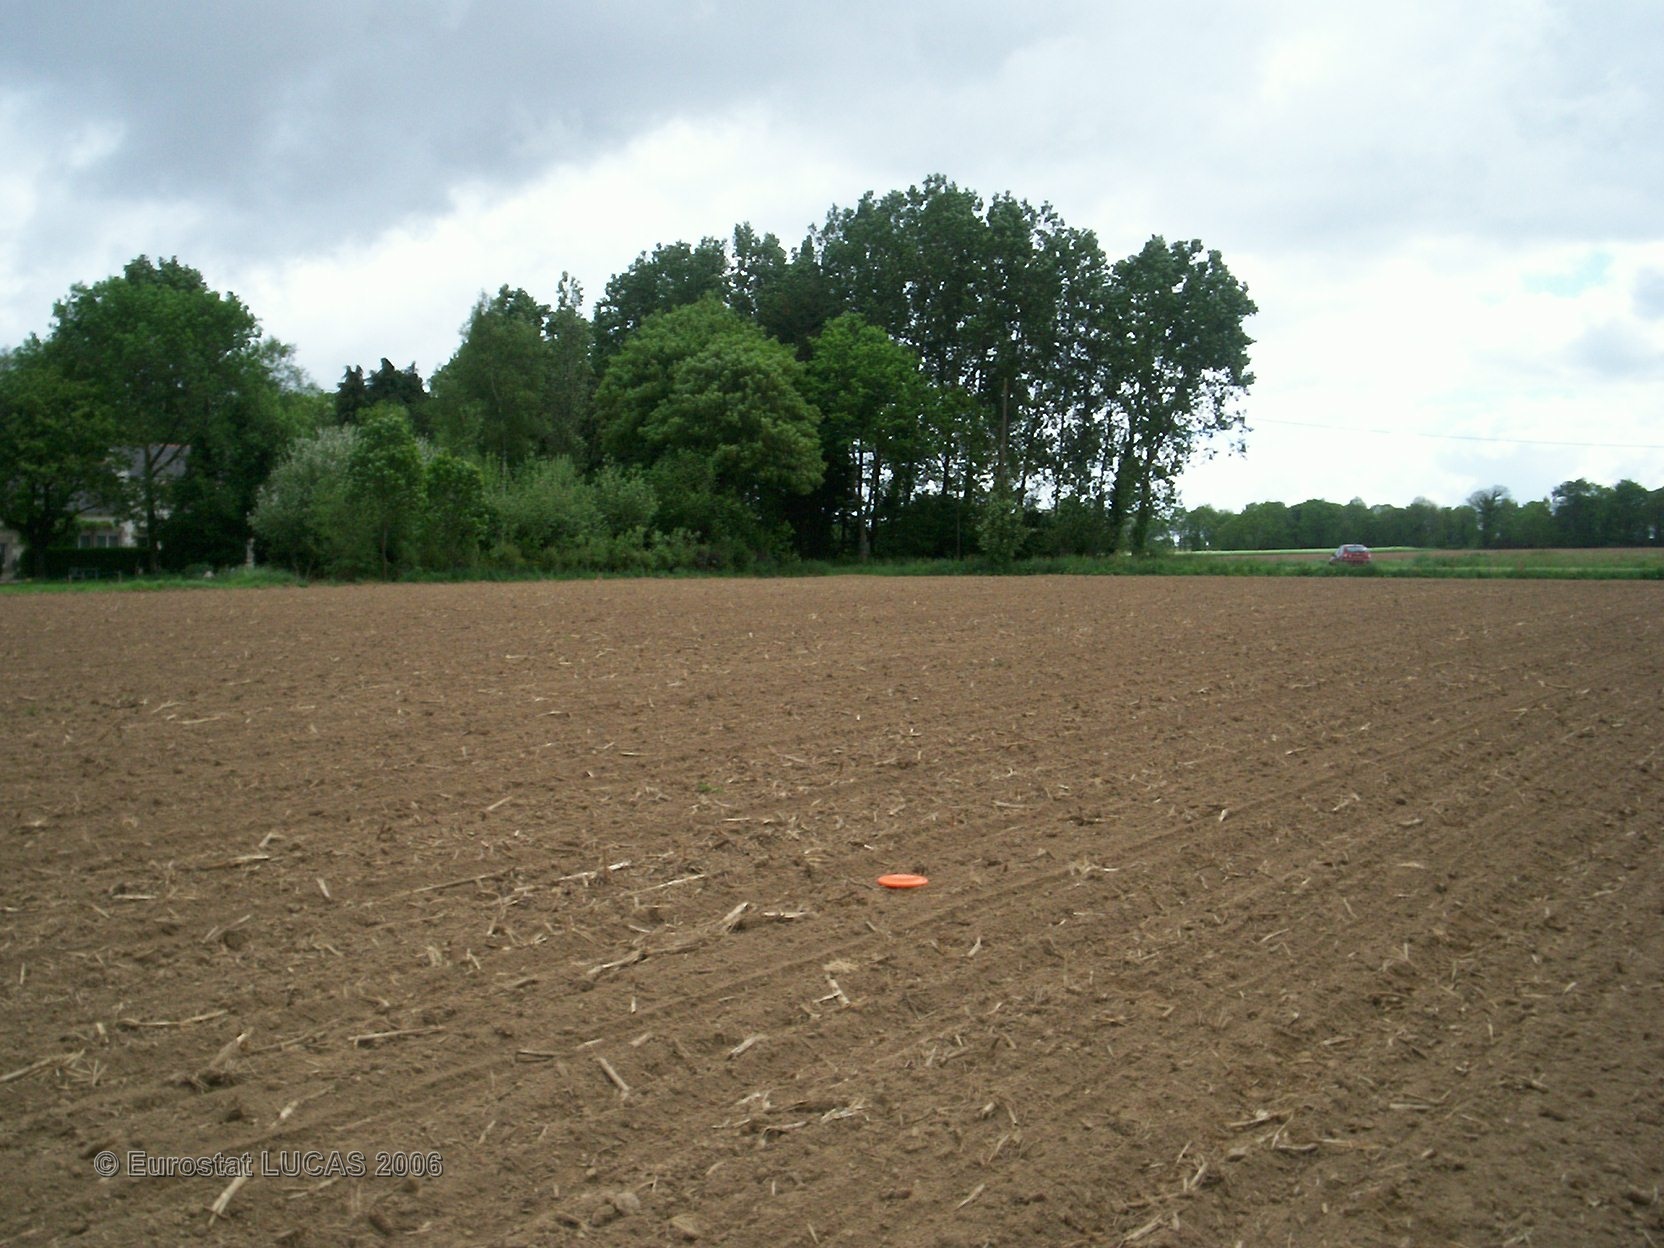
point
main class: Cropland
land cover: Maize
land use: Agriculture (excluding fallow land and kitchen gardens)
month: May
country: FR
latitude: 47.9237
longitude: -2.8455
